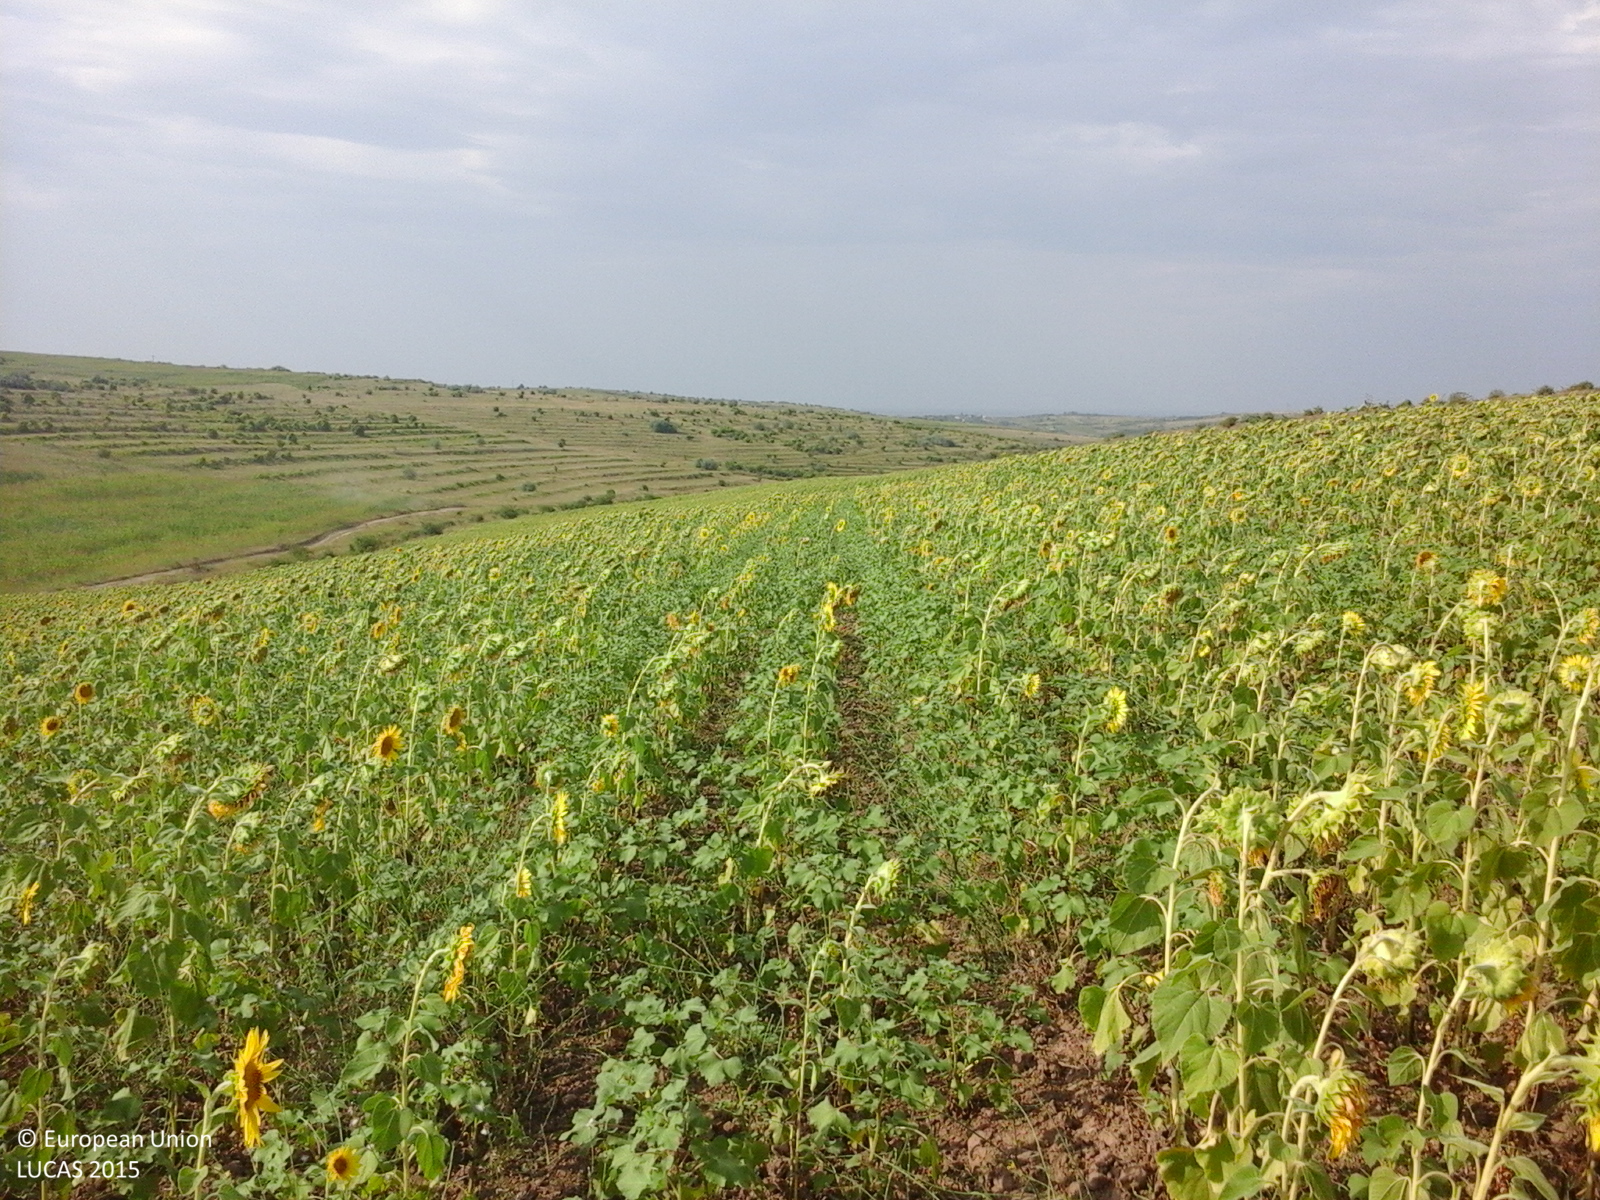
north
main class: Cropland
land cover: Sunflower
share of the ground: > 75 %
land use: Agriculture (excluding fallow land and kitchen gardens)
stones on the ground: < 10 %
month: August
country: RO
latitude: 44.2104
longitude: 27.9366
